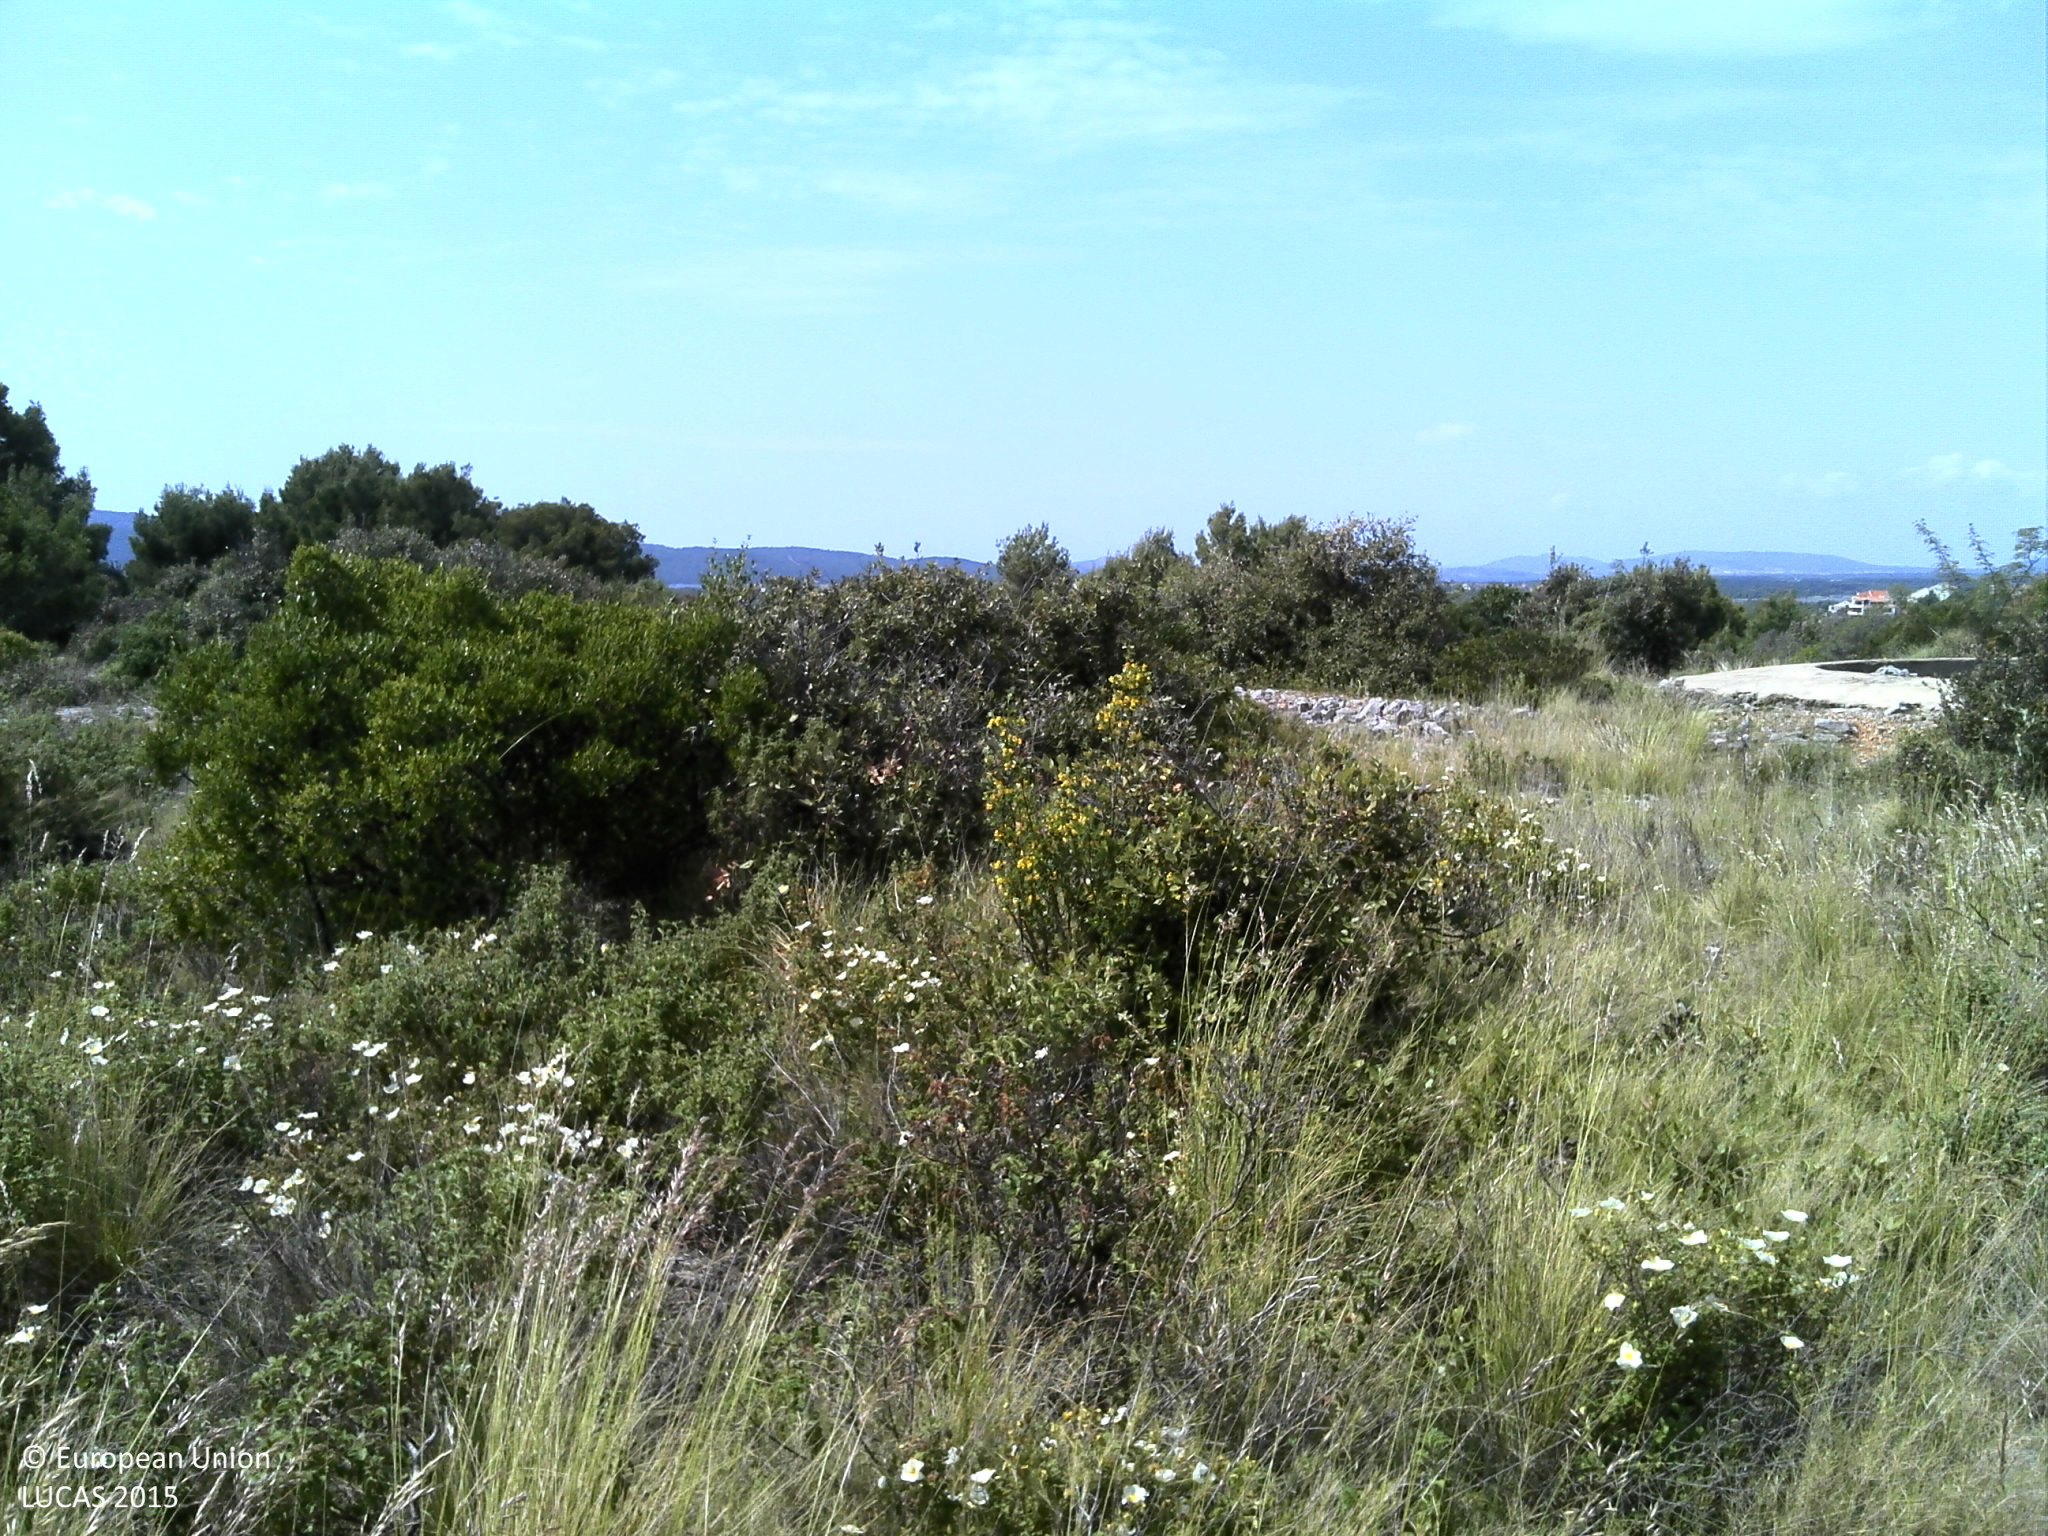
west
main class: Shrubland
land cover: Shrubland with sparse tree cover
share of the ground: 25 - 50 %
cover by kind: shrubs 35 %, herbaceous plants 30 %, consolidated bare surface 15 %, unconsolidated bare surface 15 %, coniferous forest trees 5 %
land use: Semi-natural and natural areas not in use
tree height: < 5 m
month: April
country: HR
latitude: 43.6939
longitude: 15.9092
